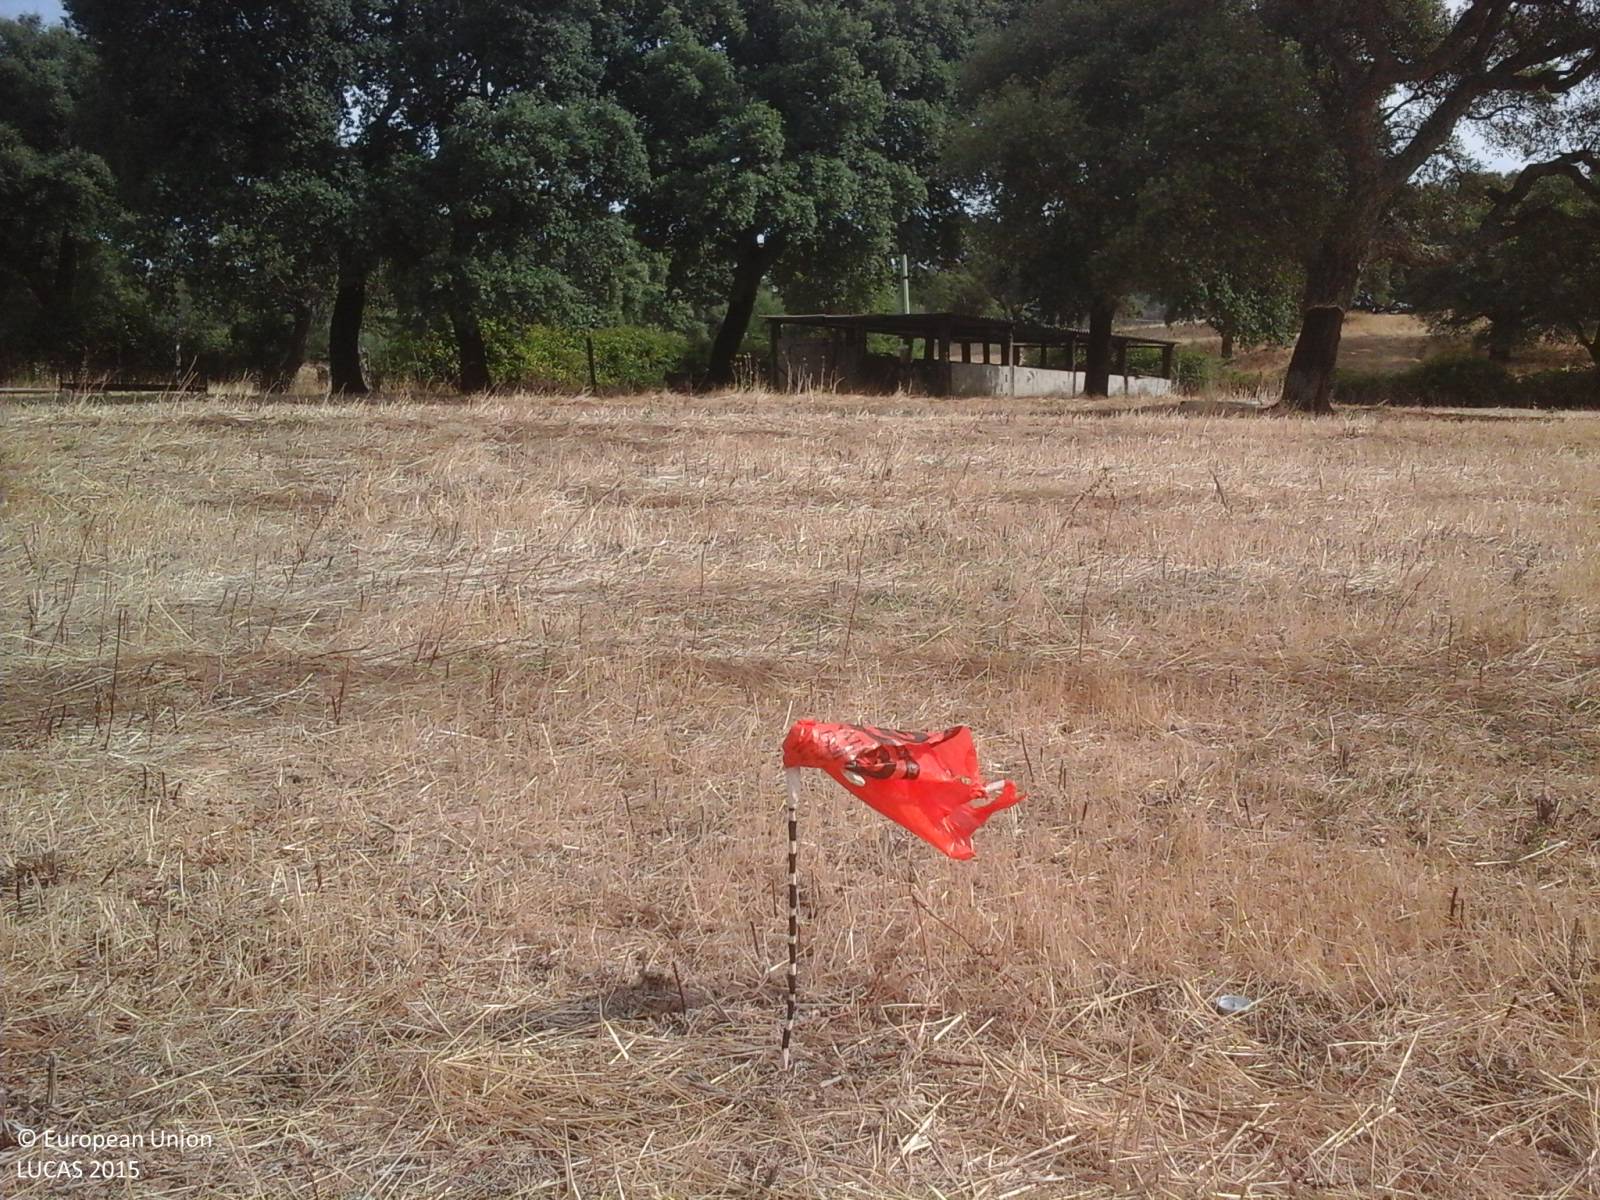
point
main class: Grassland
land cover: Grassland without tree/shrub cover
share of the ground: > 75 %
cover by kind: herbaceous plants 100 %
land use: Agriculture (excluding fallow land and kitchen gardens)
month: July
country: IT
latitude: 40.8075
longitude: 9.2568
